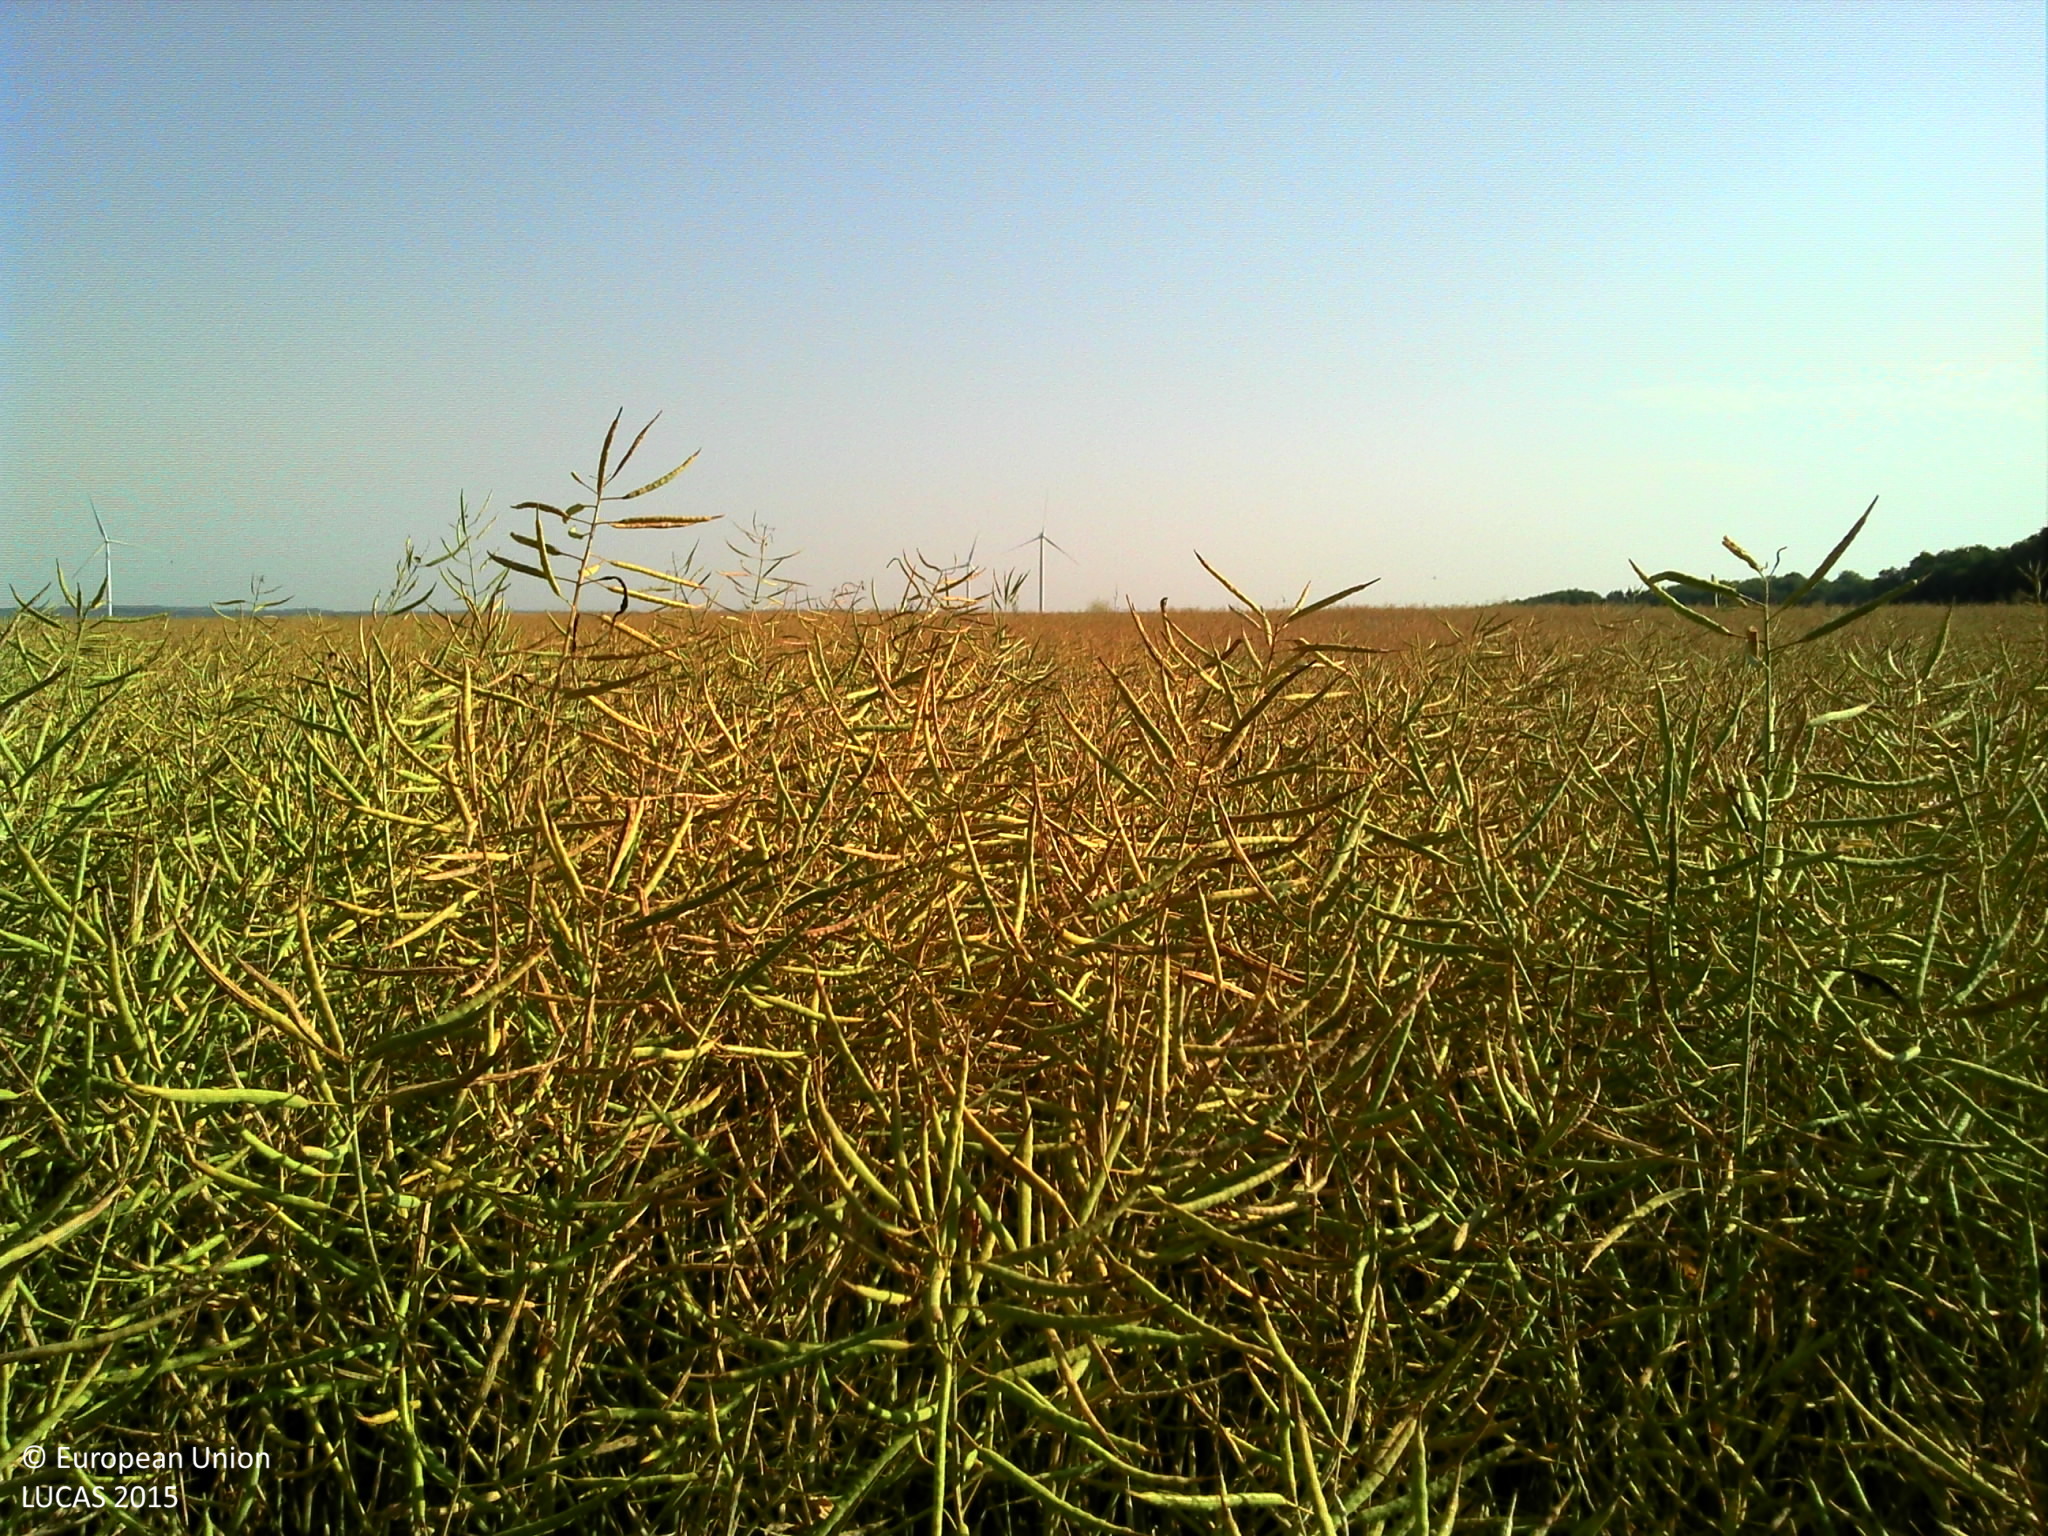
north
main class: Cropland
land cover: Rape and turnip rape
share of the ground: > 75 %
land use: Agriculture (excluding fallow land and kitchen gardens)
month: July
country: FR
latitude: 48.1383
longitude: 5.2287
